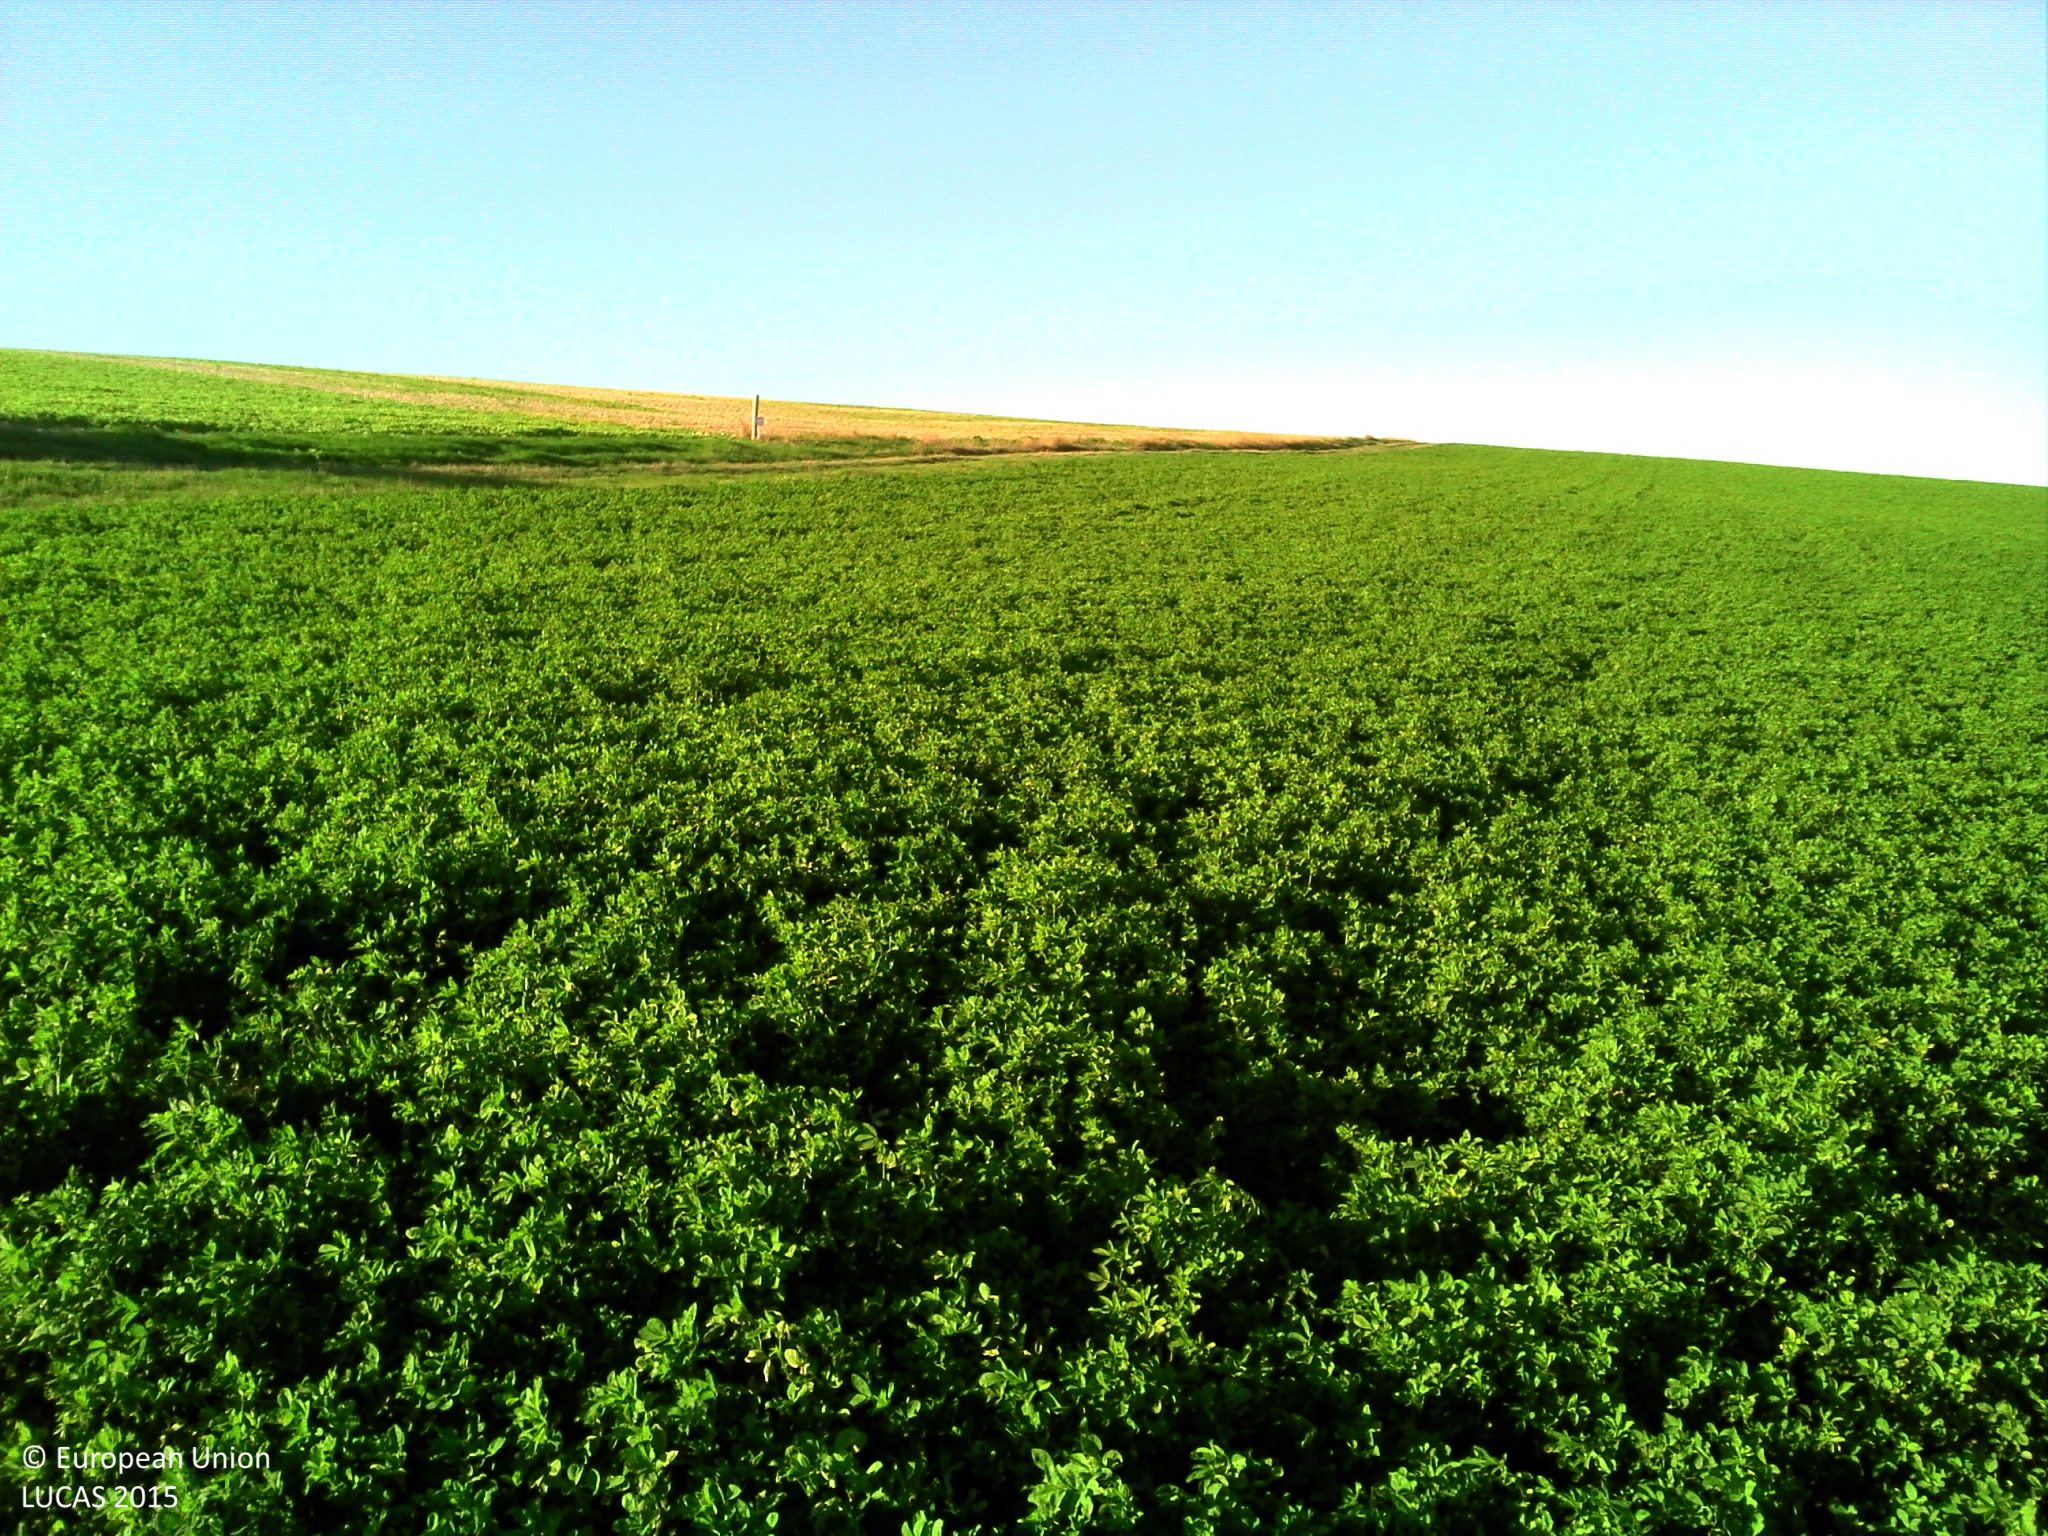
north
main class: Cropland
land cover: Lucerne
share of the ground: > 75 %
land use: Agriculture (excluding fallow land and kitchen gardens)
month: September
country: FR
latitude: 48.3075
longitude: 4.2397
